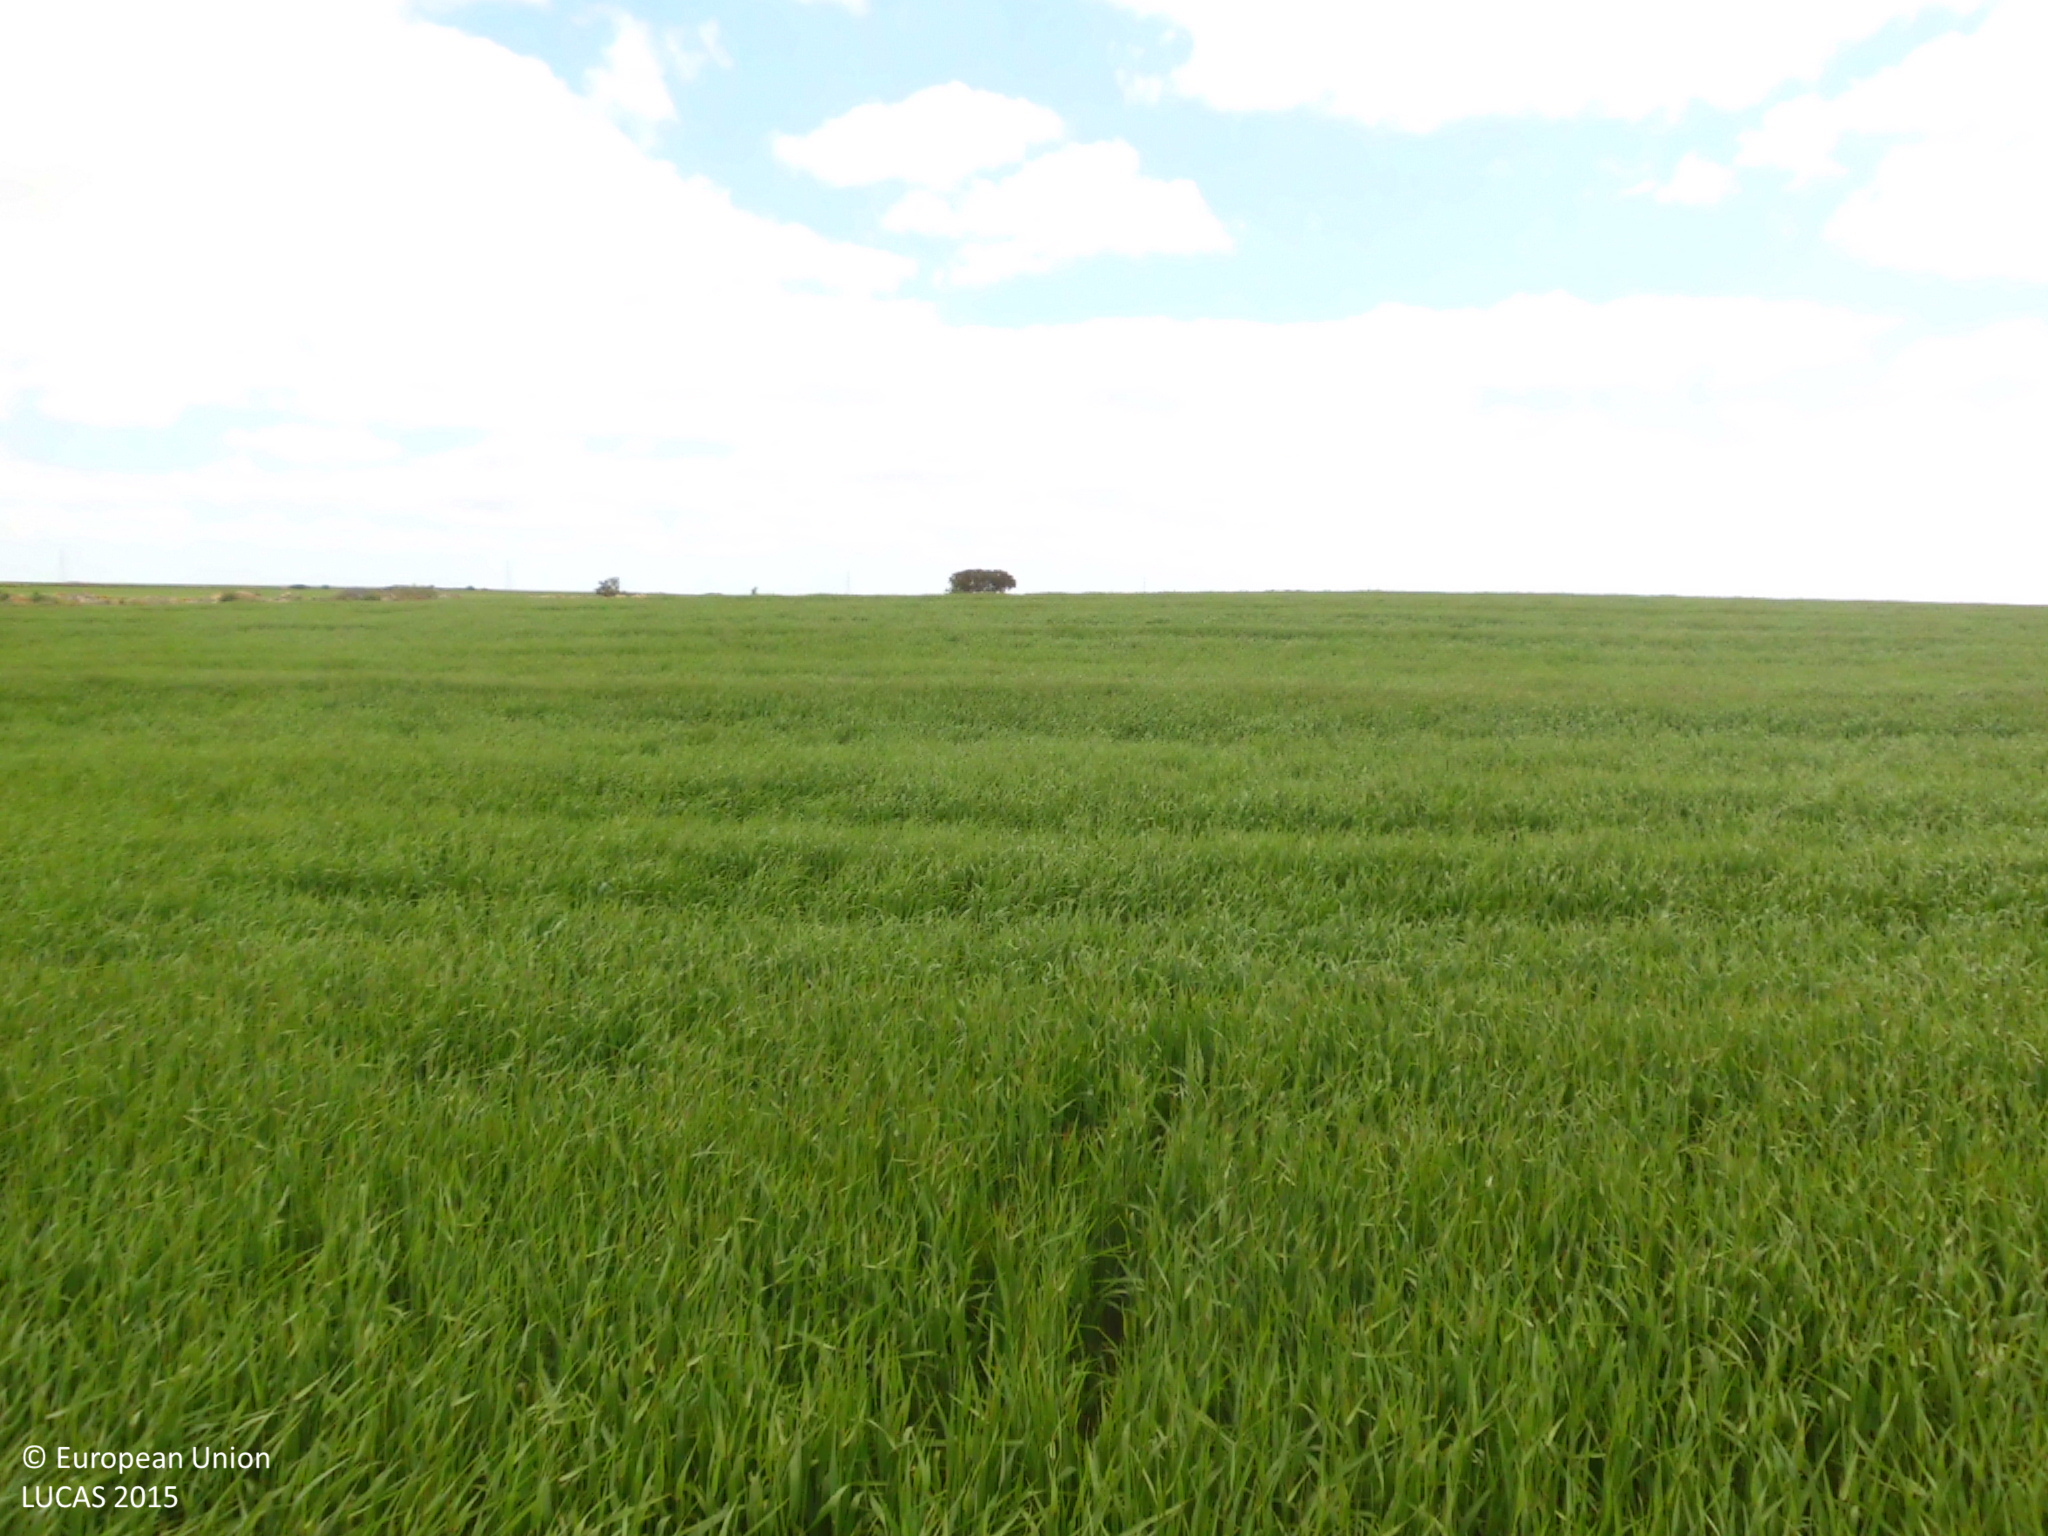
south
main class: Cropland
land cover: Barley
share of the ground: > 75 %
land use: Agriculture (excluding fallow land and kitchen gardens)
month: May
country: ES
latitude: 42.3193
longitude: -3.9820
